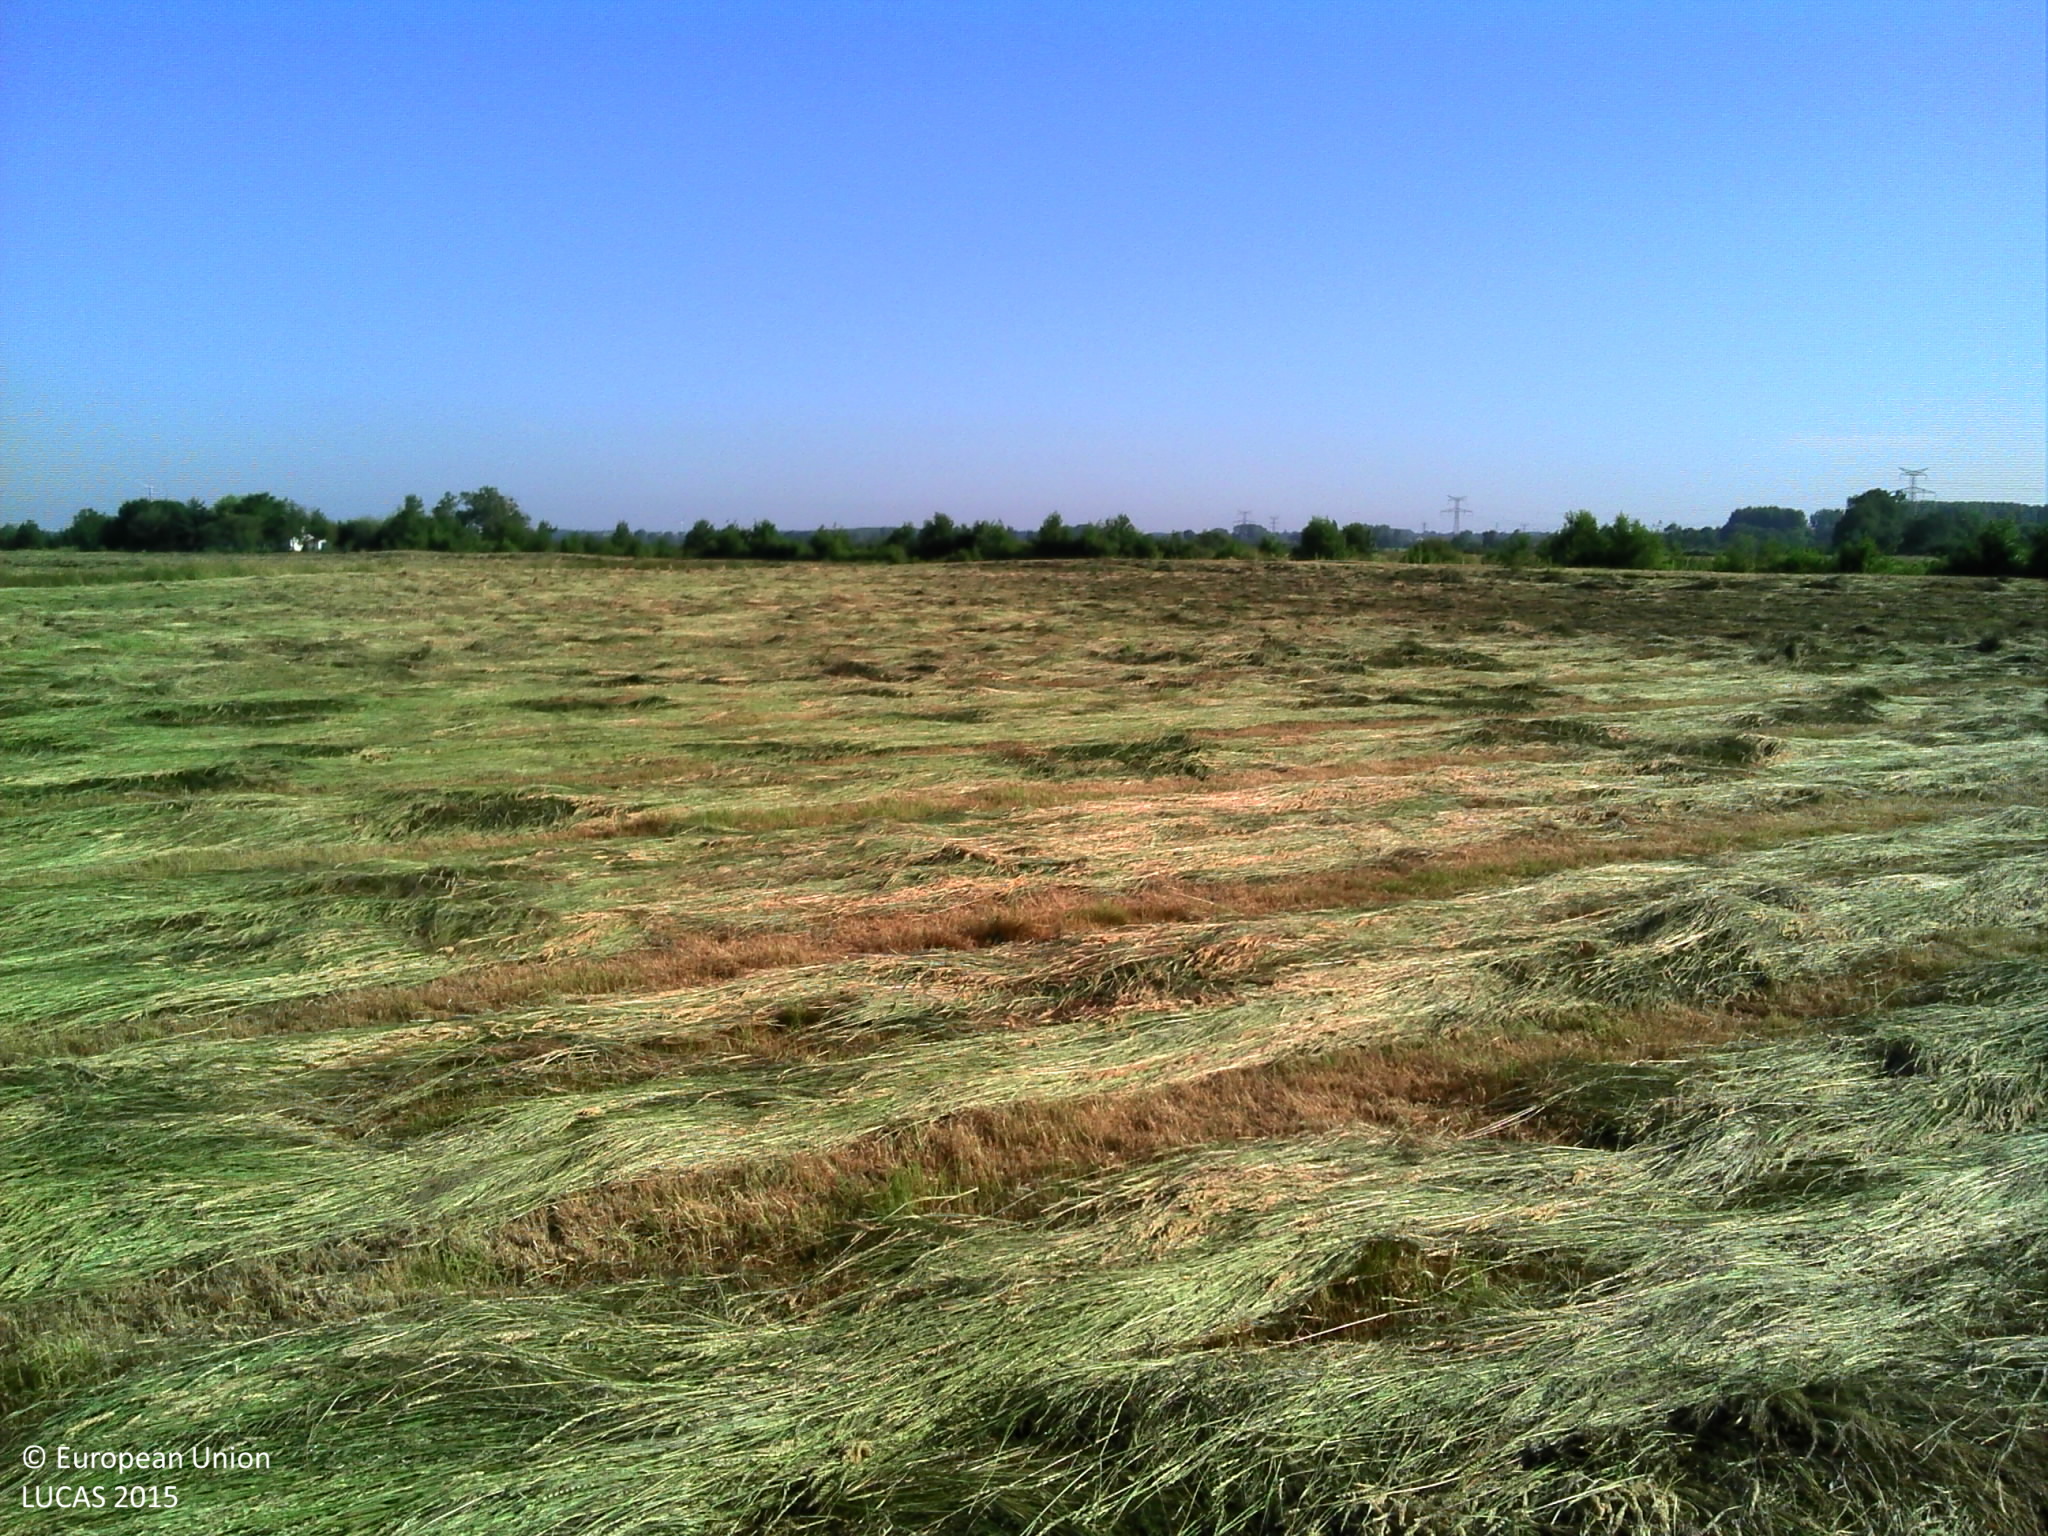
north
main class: Grassland
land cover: Grassland without tree/shrub cover
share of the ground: > 75 %
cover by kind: herbaceous plants 100 %
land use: Agriculture (excluding fallow land and kitchen gardens)
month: June
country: FR
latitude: 46.9979
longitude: -1.8676
